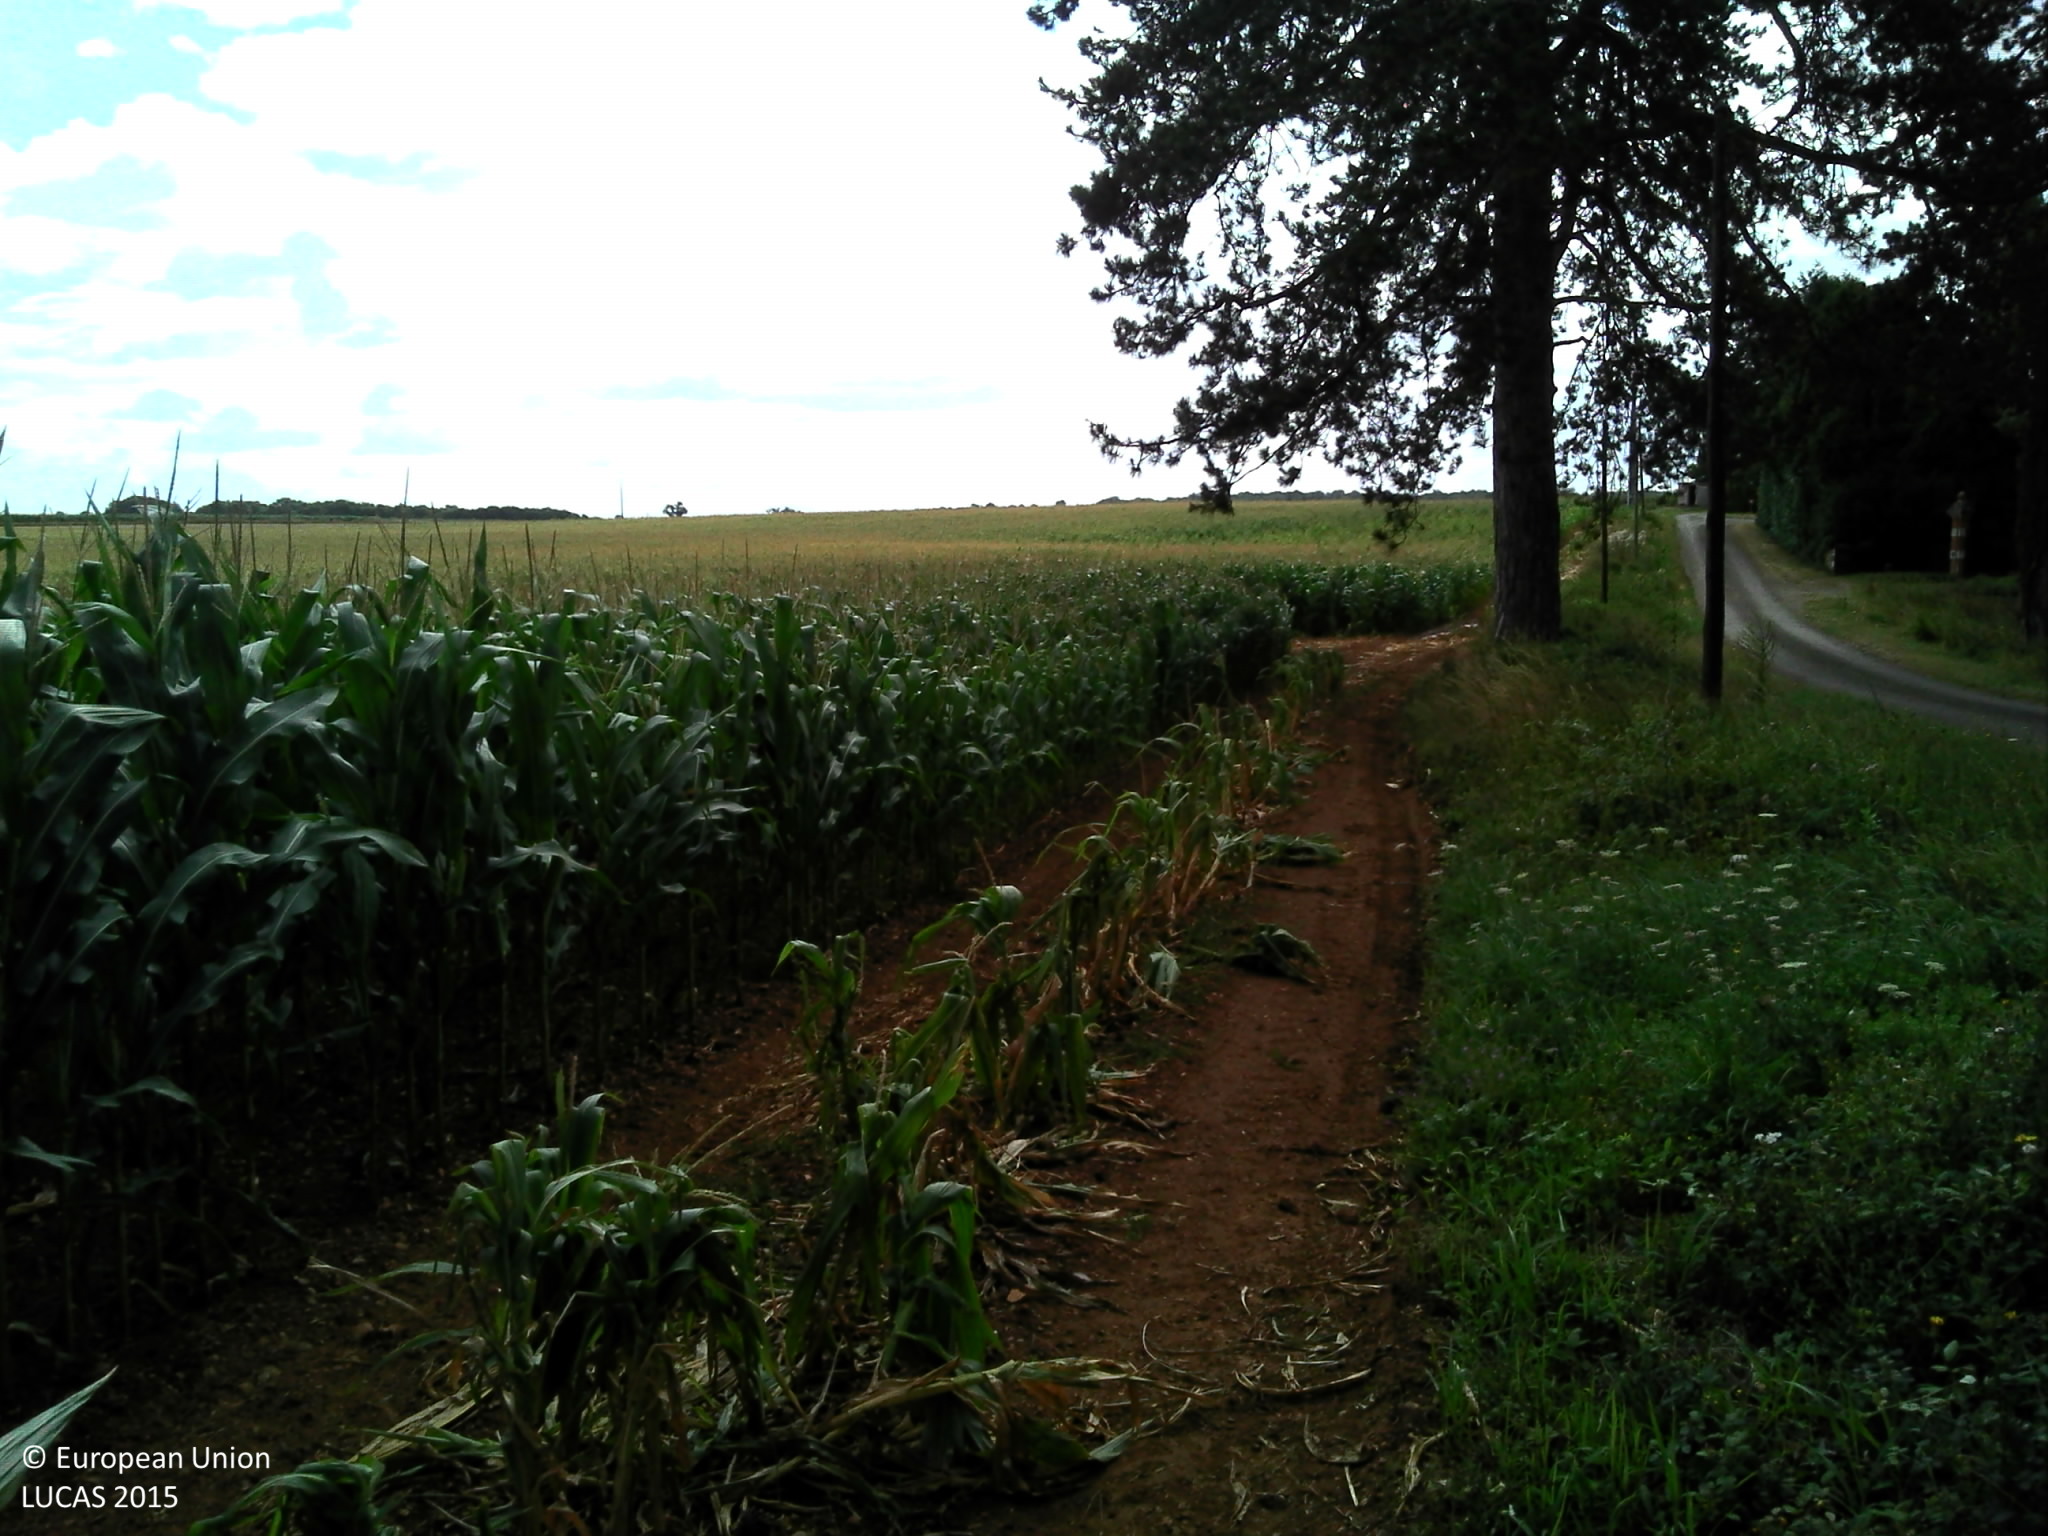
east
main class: Cropland
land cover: Maize
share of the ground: > 75 %
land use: Agriculture (excluding fallow land and kitchen gardens)
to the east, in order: Maize; Common wheat; Grass margins
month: July
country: FR
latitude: 46.3424
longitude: 0.2758
